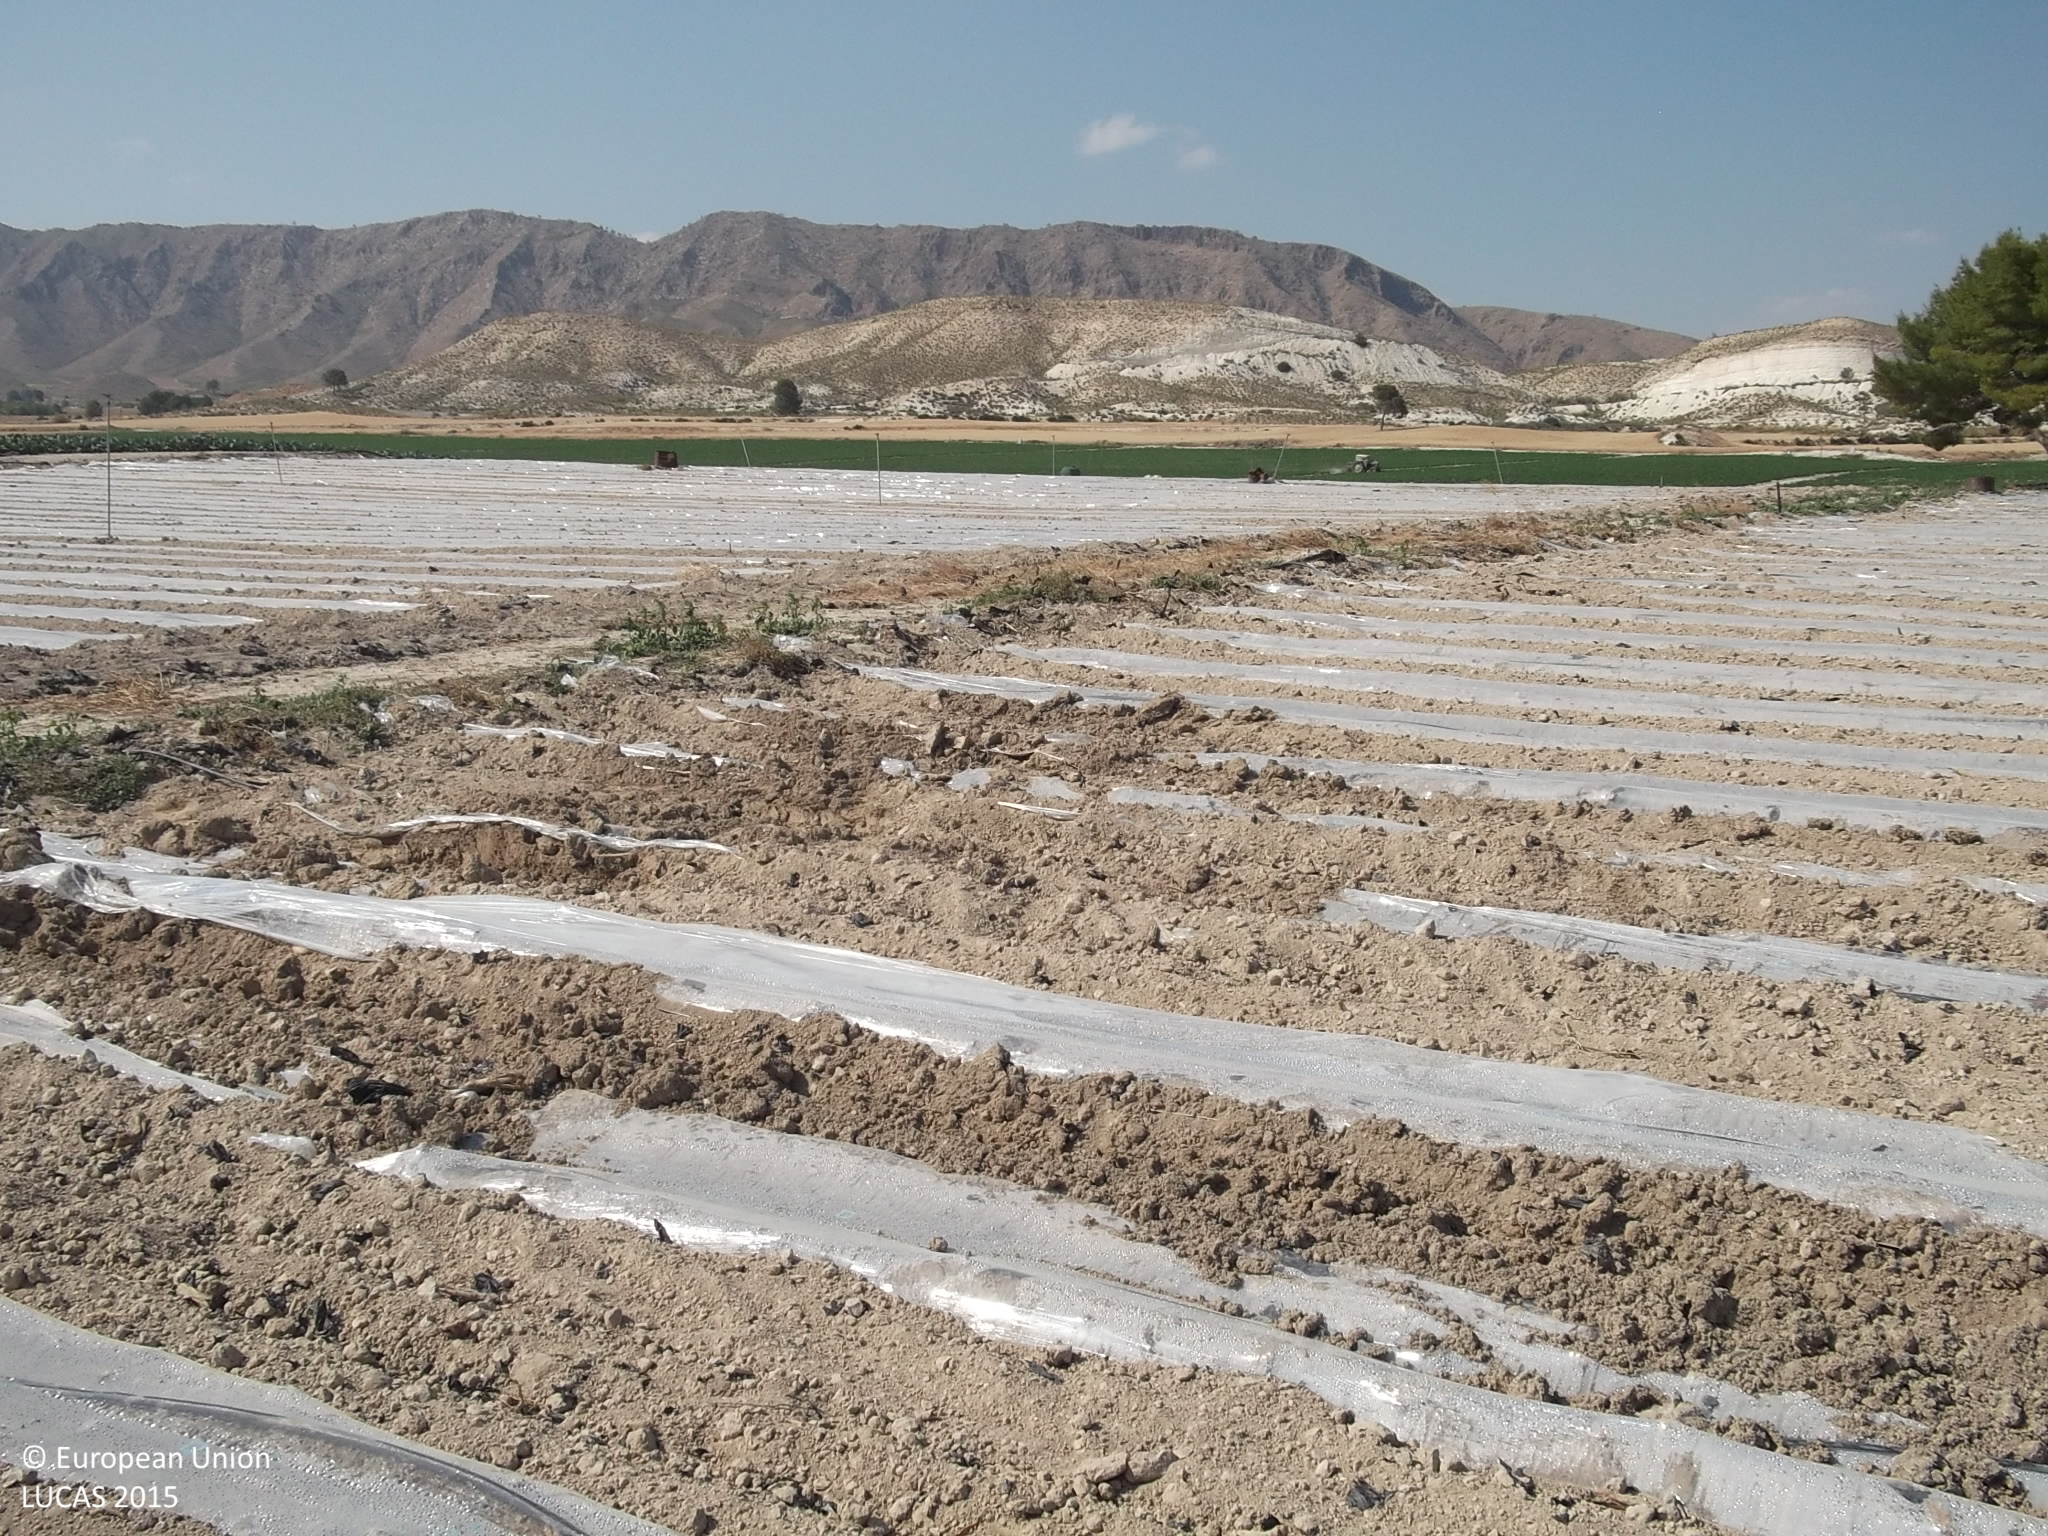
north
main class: Cropland
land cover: Other fresh vegetables
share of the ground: > 75 %
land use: Agriculture (excluding fallow land and kitchen gardens)
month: May
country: ES
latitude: 38.3642
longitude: -1.6536
